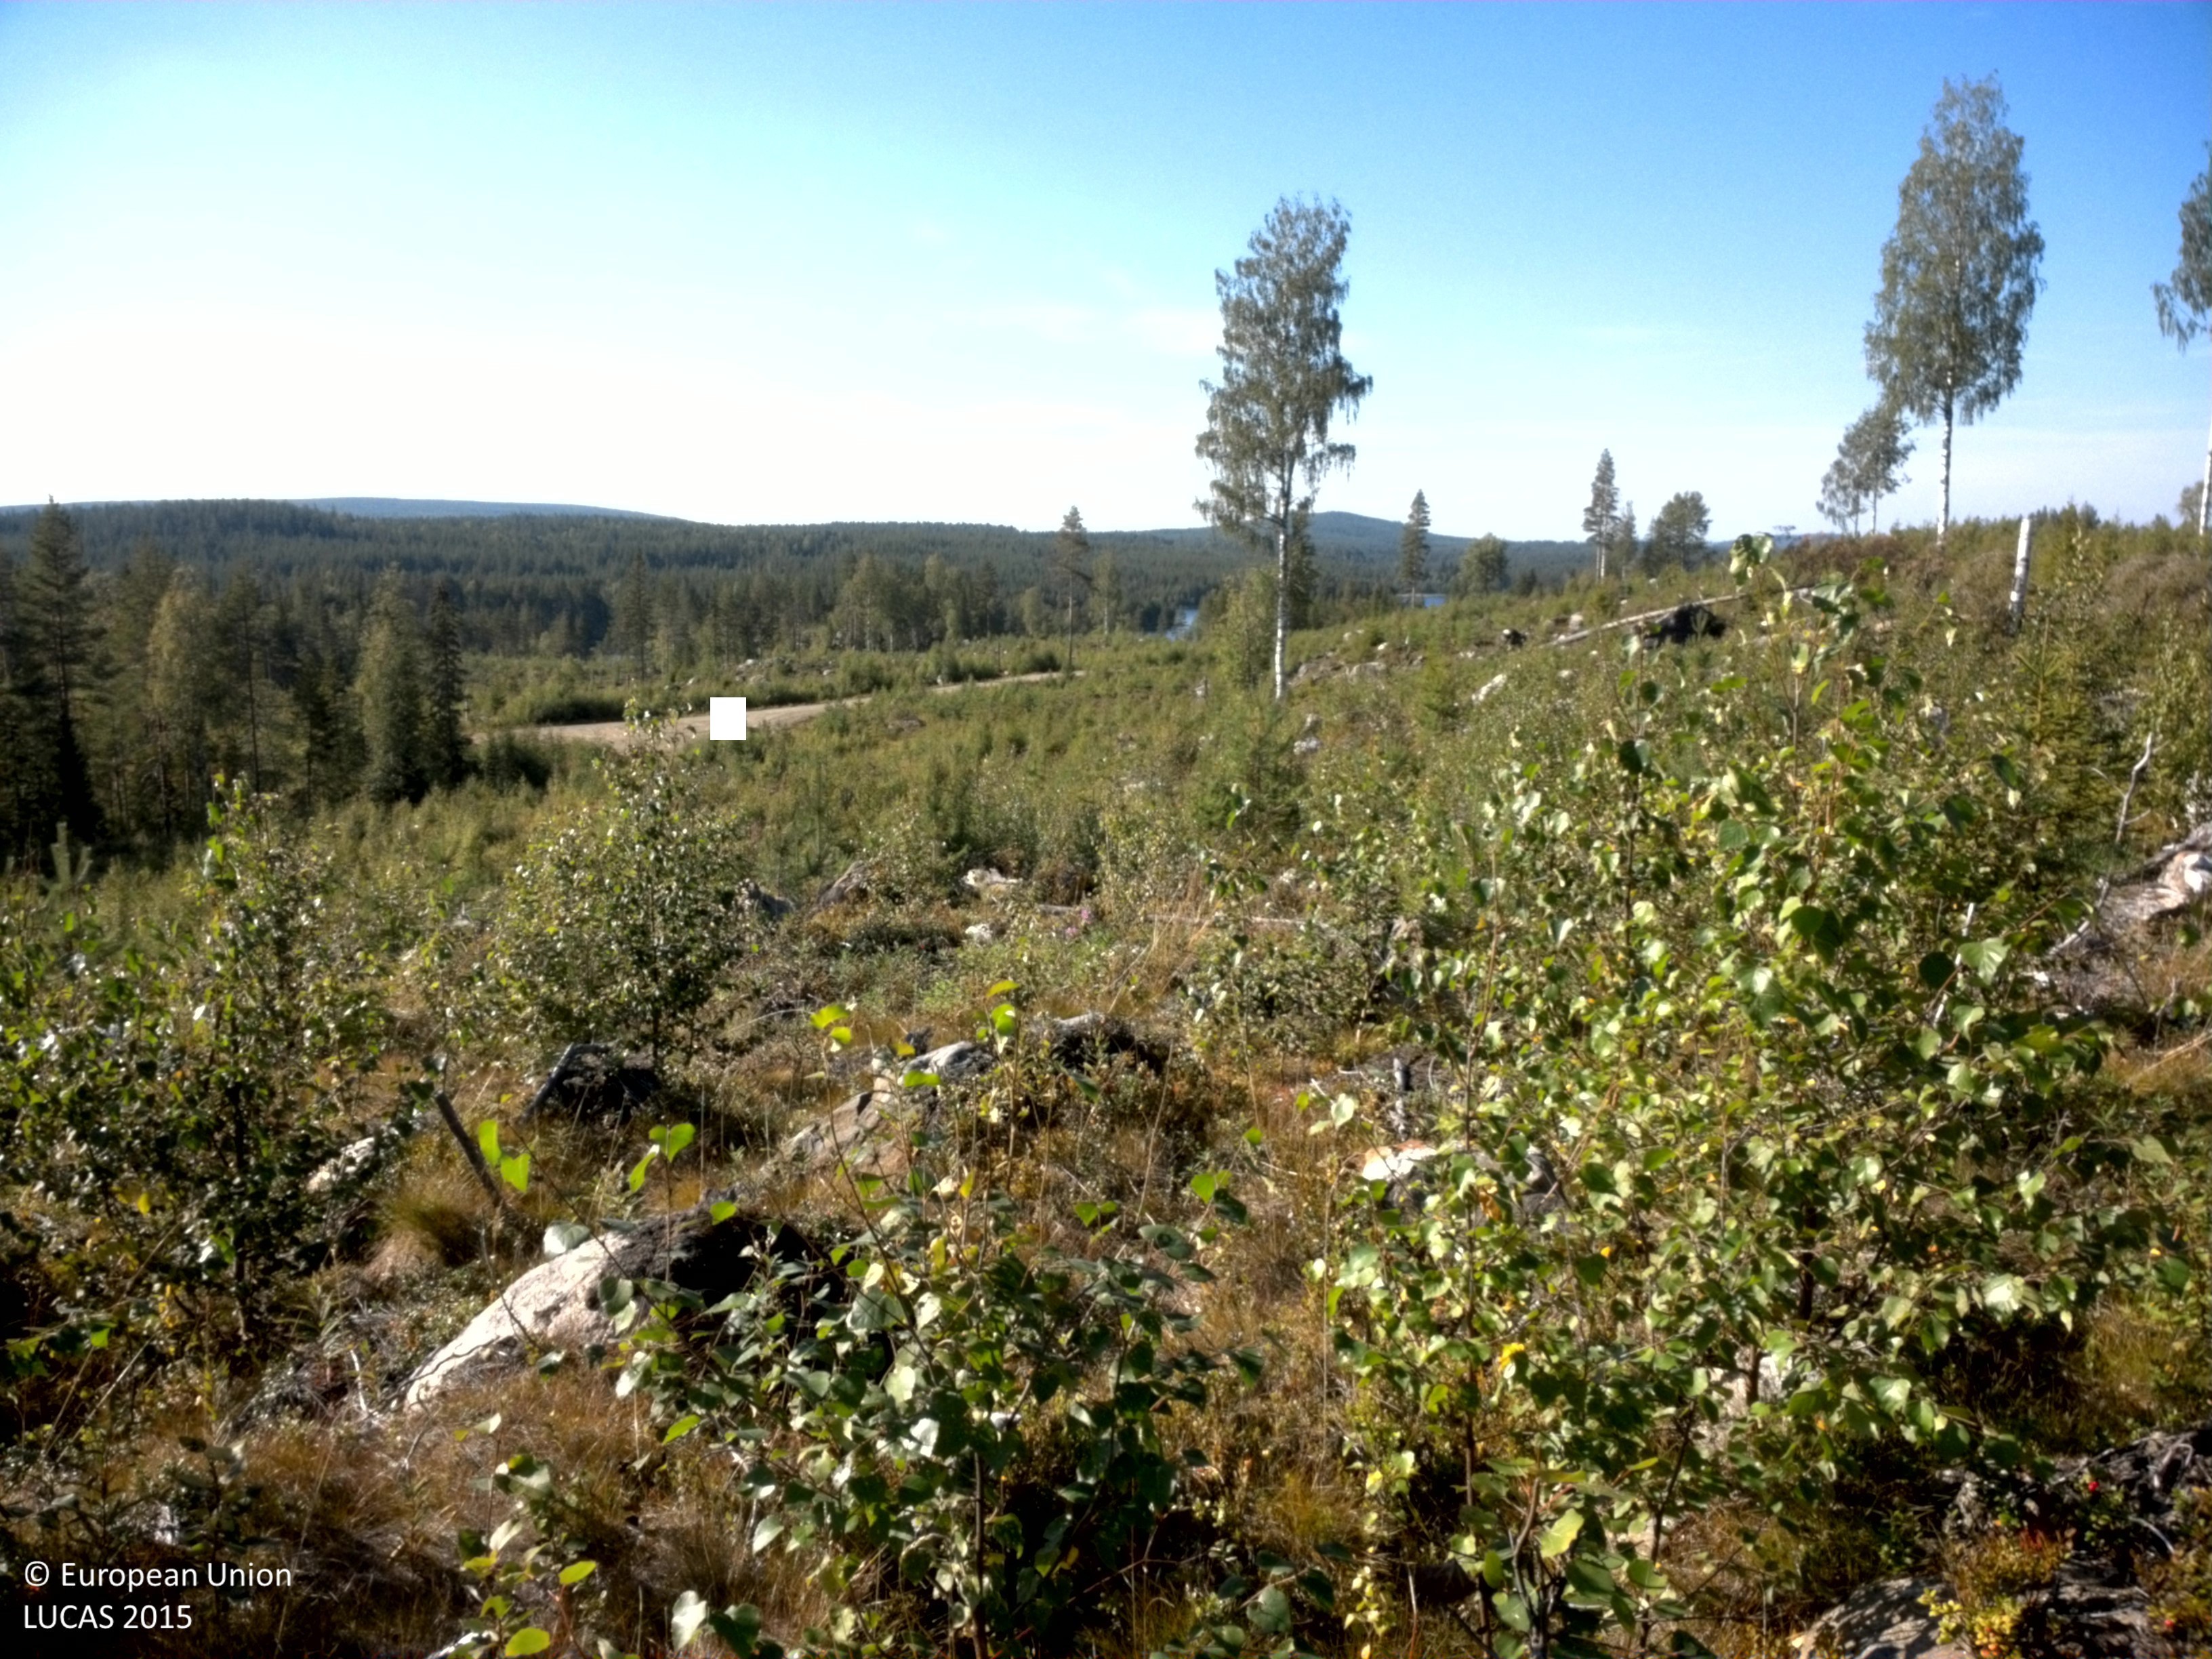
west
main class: Woodland
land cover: Broadleaved woodland
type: boreal forest
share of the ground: 25 - 50 %
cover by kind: shrubs 50 %, broadleaved forest trees 40 %, coniferous forest trees 5 %, herbaceous plants 5 %
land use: Forestry
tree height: < 5 m
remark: Clear cut
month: August
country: SE
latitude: 64.3058
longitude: 19.0050
